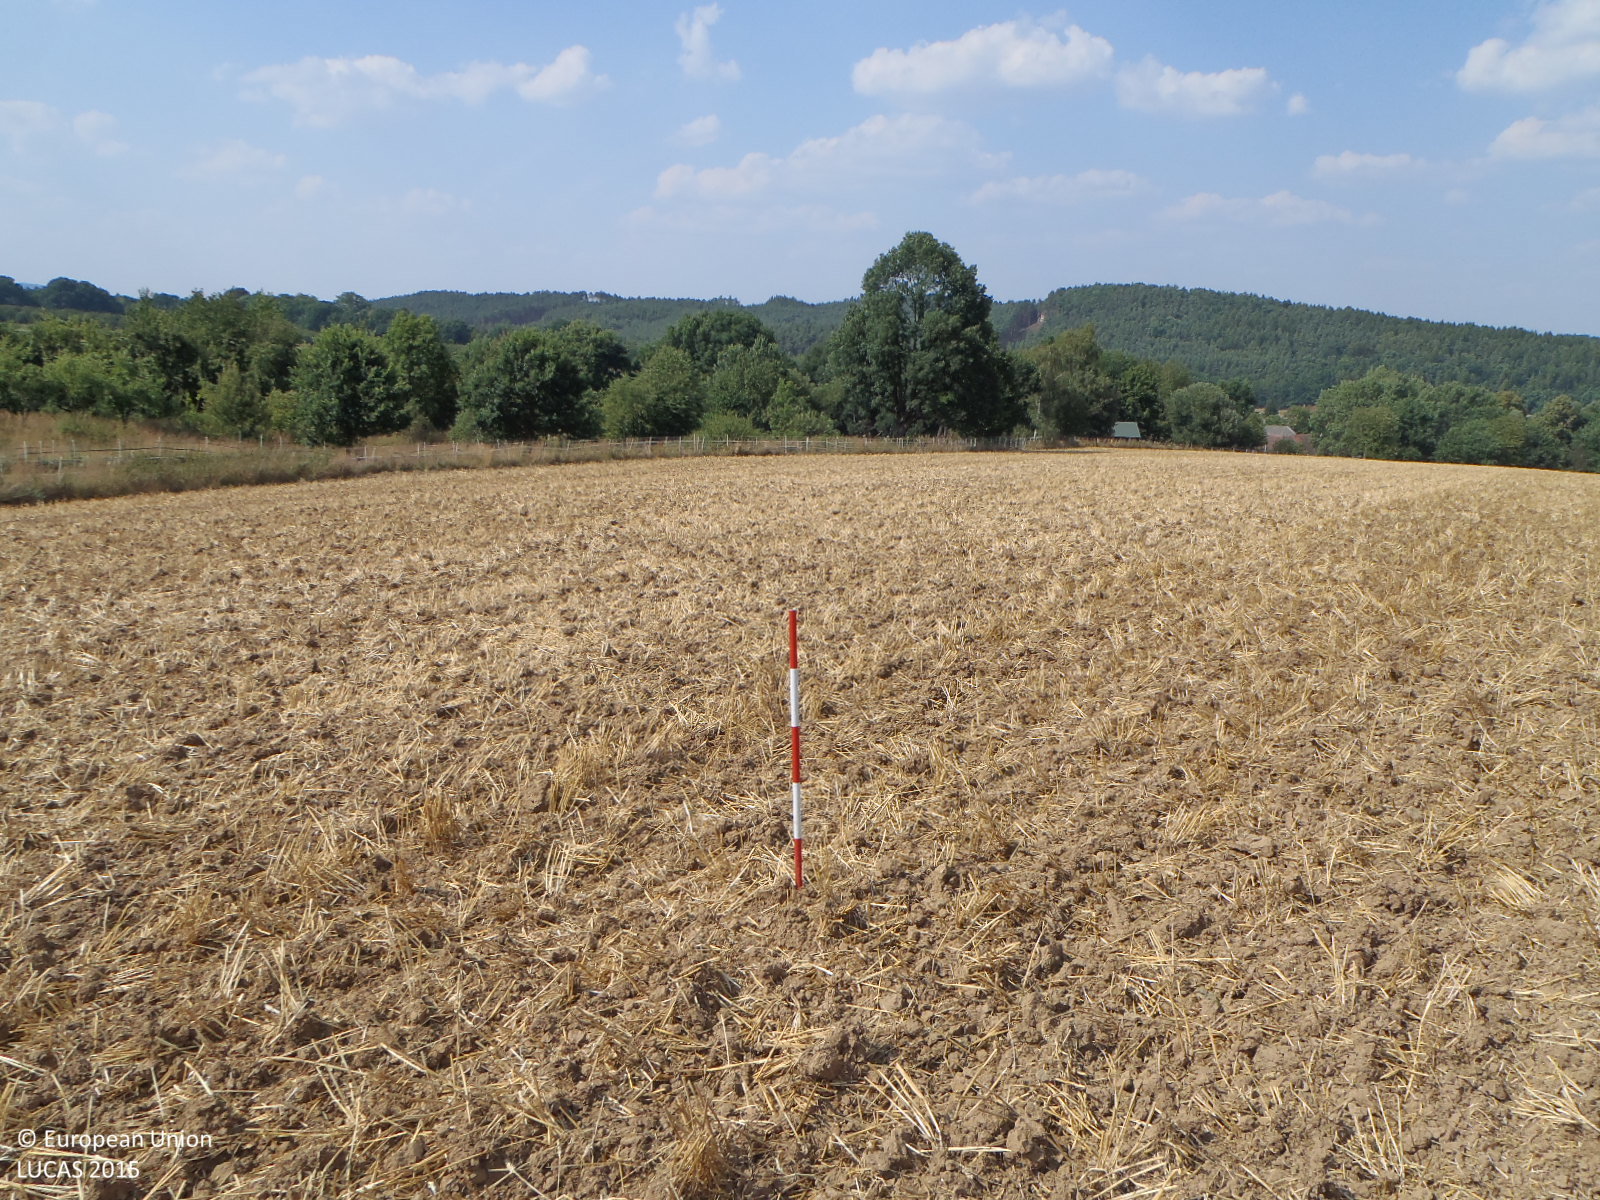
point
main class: Cropland
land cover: Common wheat
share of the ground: 25 - 50 %
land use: Agriculture (excluding fallow land and kitchen gardens)
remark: Harvested field
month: August
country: CZ
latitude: 50.5971
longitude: 14.5651
